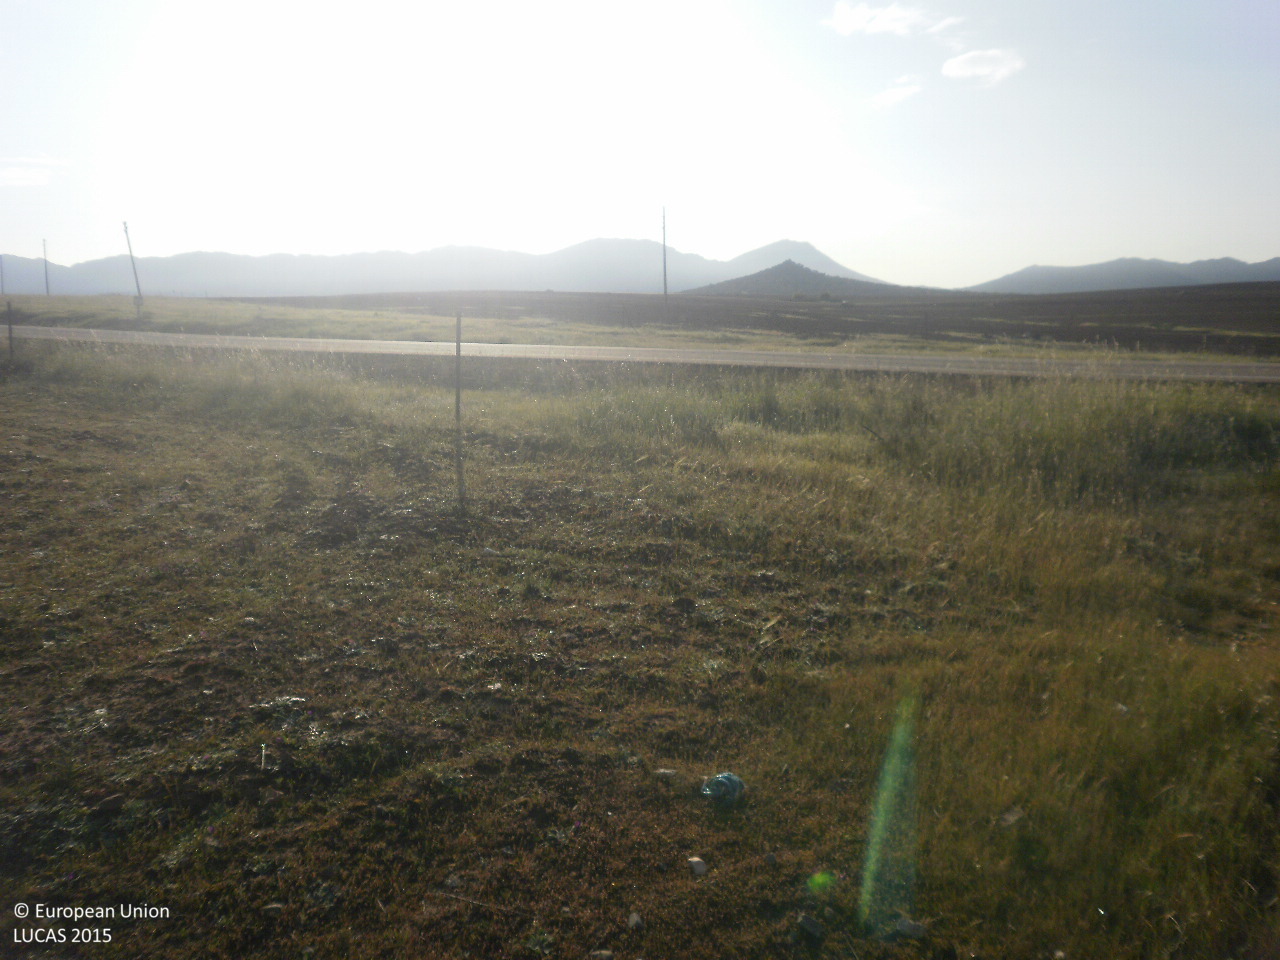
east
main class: Grassland
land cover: Grassland without tree/shrub cover
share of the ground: > 75 %
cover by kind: herbaceous plants 100 %
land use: Agriculture (excluding fallow land and kitchen gardens)
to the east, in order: Grassland without tree/shrub cover
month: April
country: ES
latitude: 38.7782
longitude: -5.2183
